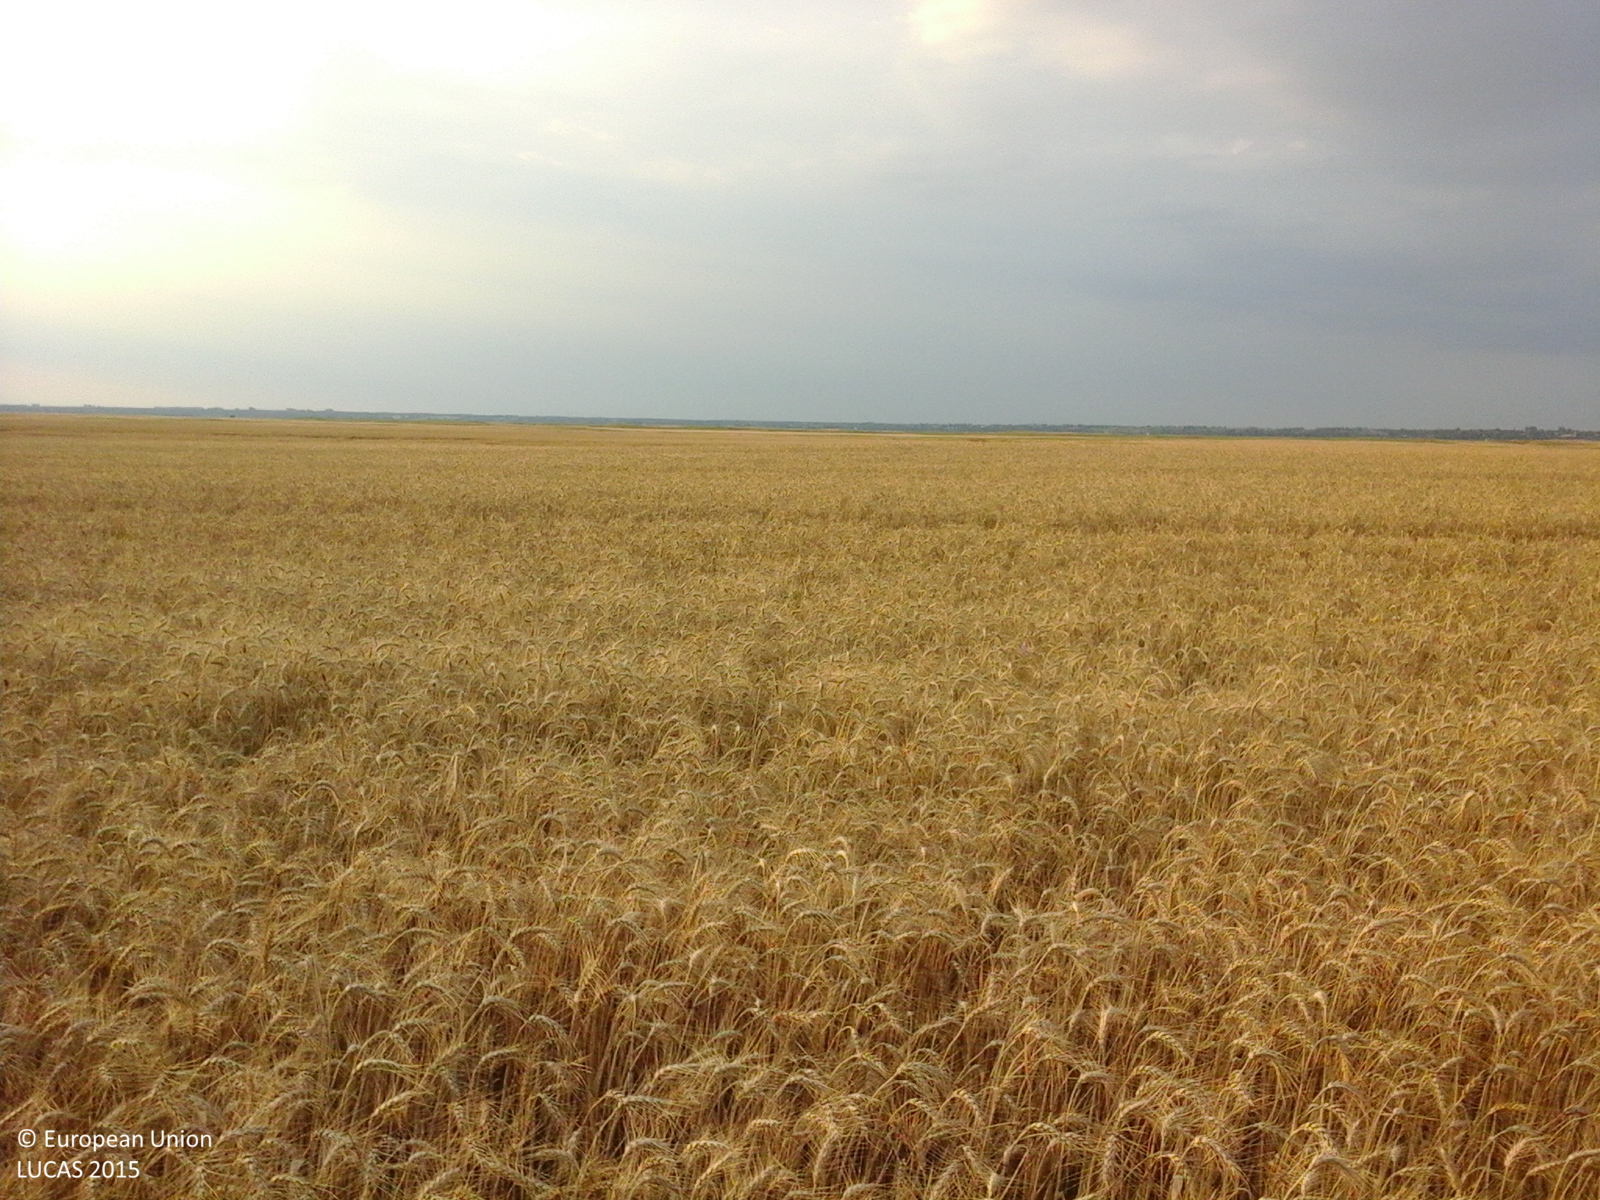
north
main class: Cropland
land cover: Common wheat
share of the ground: > 75 %
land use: Agriculture (excluding fallow land and kitchen gardens)
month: July
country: RO
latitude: 43.7198
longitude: 24.1710
